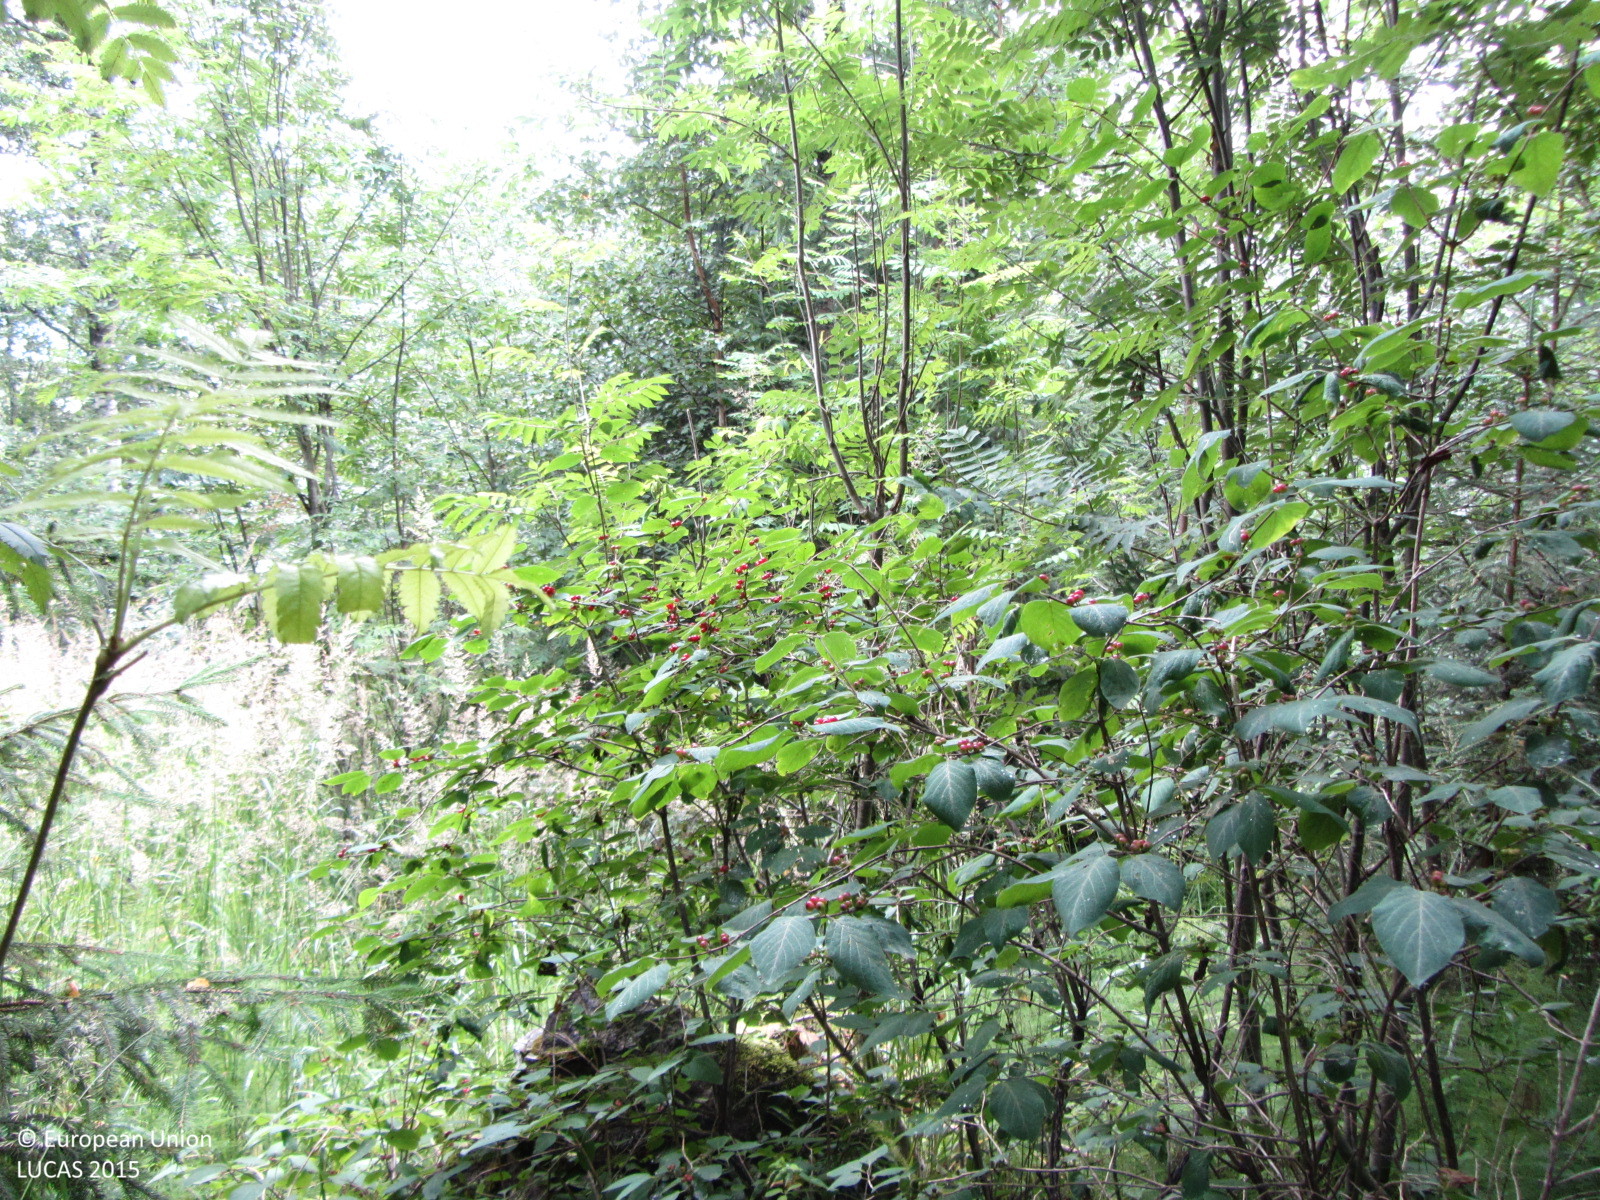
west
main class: Woodland
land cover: Broadleaved woodland
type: boreal forest
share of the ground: > 75 %
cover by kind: broadleaved forest trees 85 %, herbaceous plants 10 %, coniferous forest trees 5 %
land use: Forestry
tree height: > 5 m
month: July
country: FI
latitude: 60.4730
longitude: 24.3092
